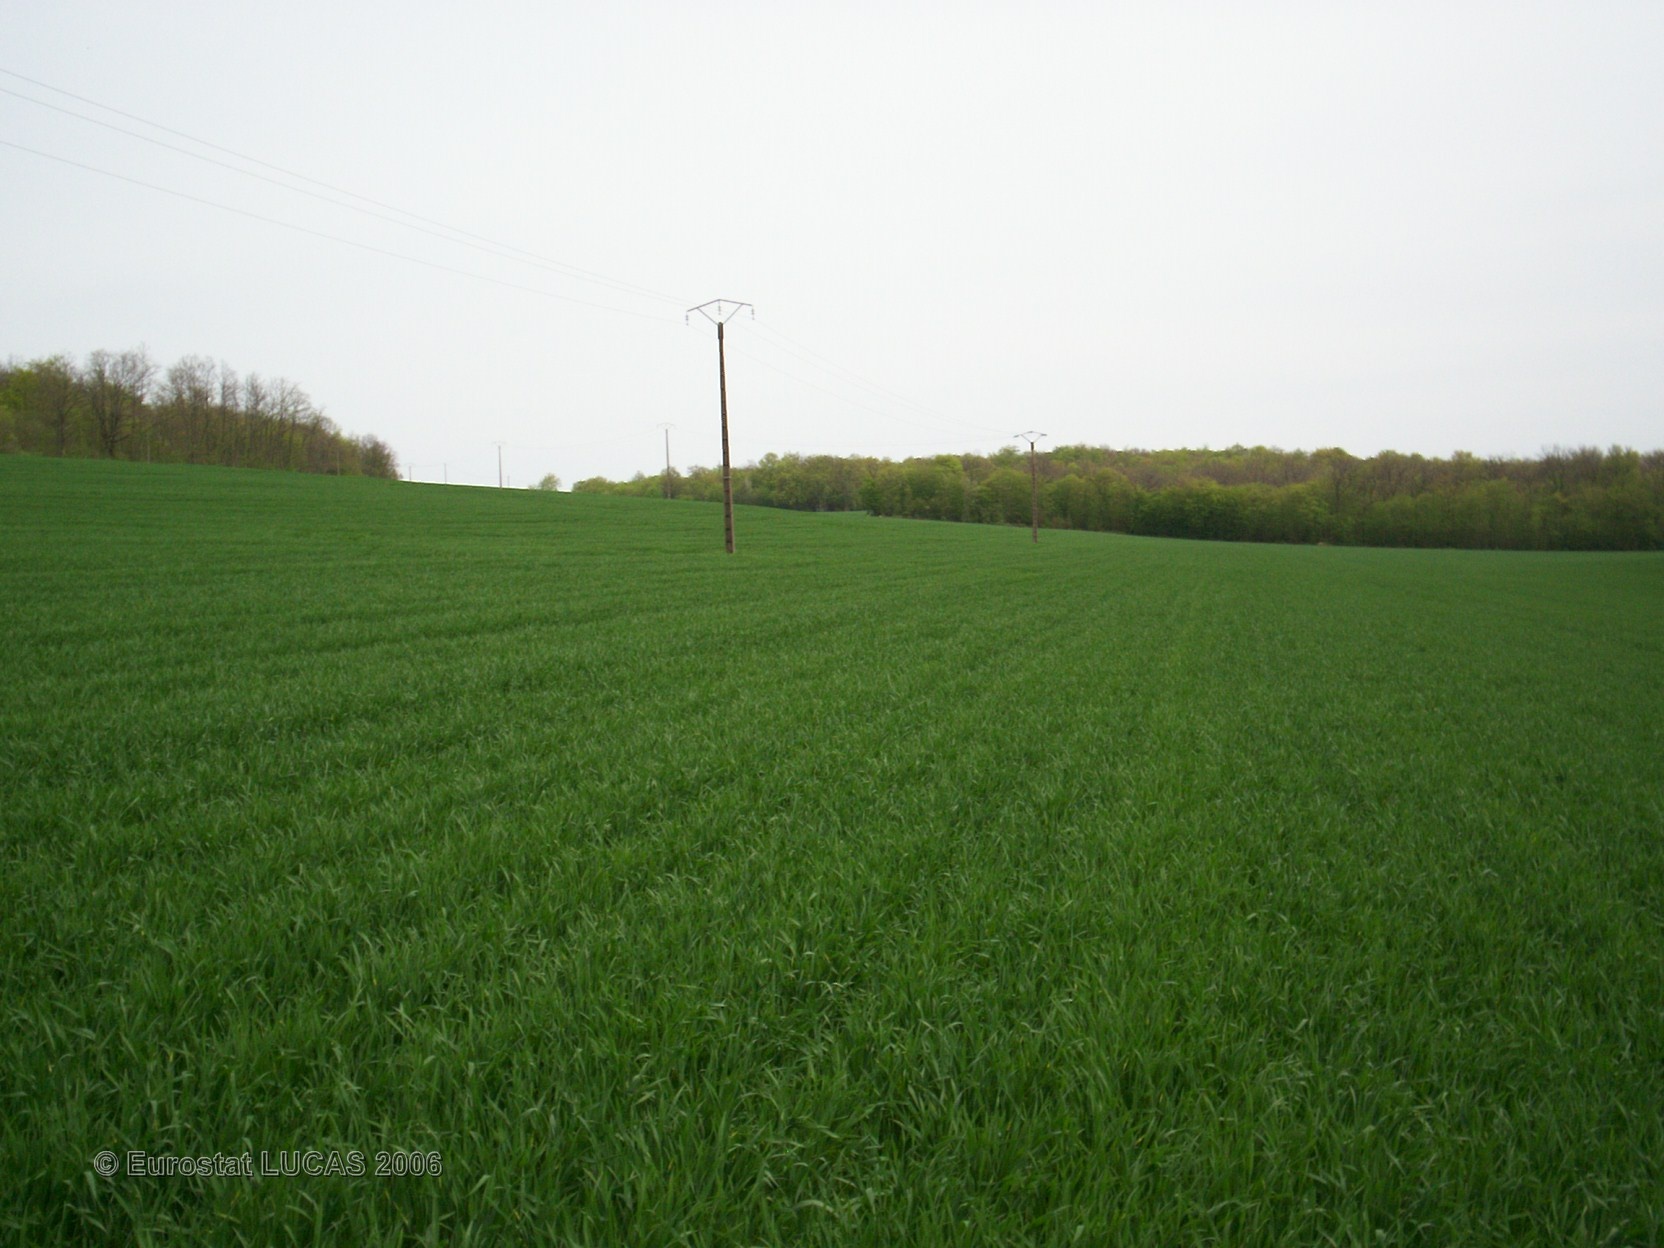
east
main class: Cropland
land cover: Common wheat
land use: Agriculture (excluding fallow land and kitchen gardens)
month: May
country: FR
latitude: 47.6740
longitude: 4.5513
